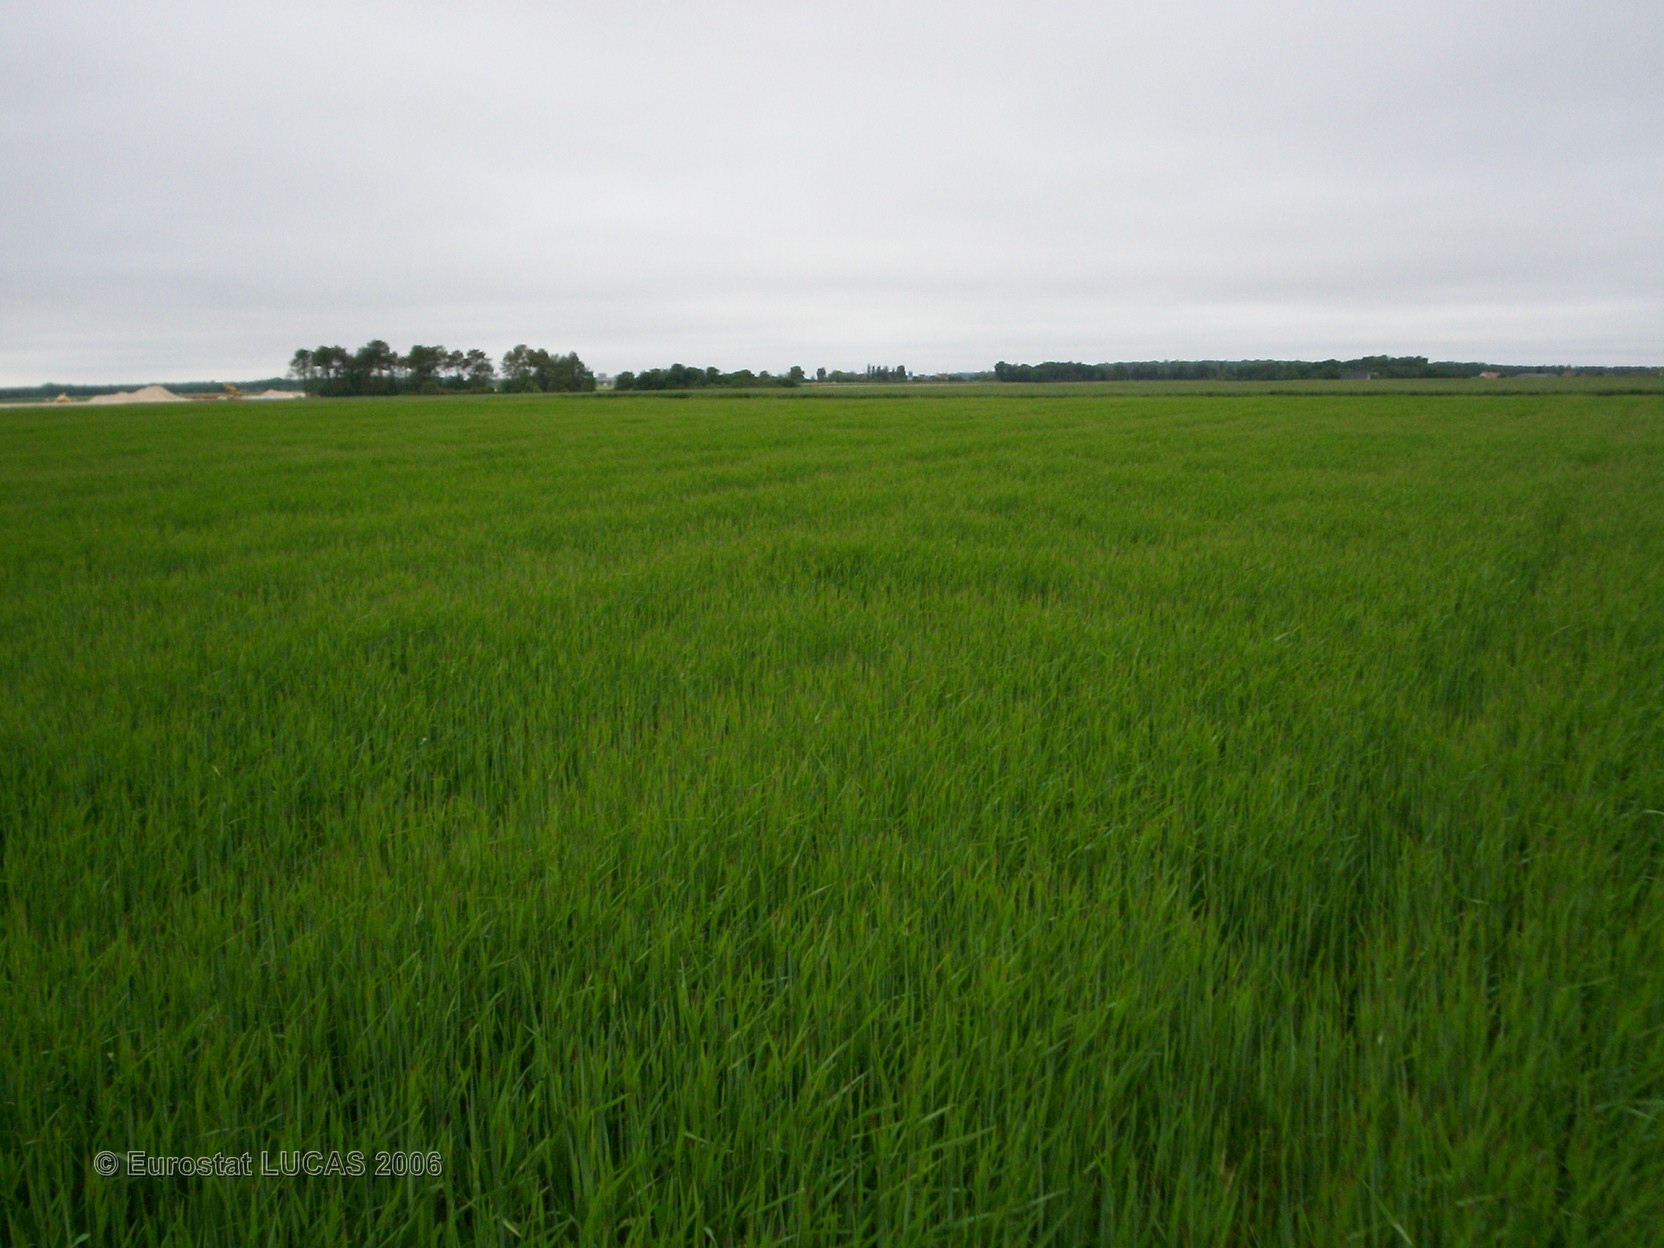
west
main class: Cropland
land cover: Triticale
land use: Agriculture (excluding fallow land and kitchen gardens)
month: May
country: FR
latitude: 47.3029
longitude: 0.8963
